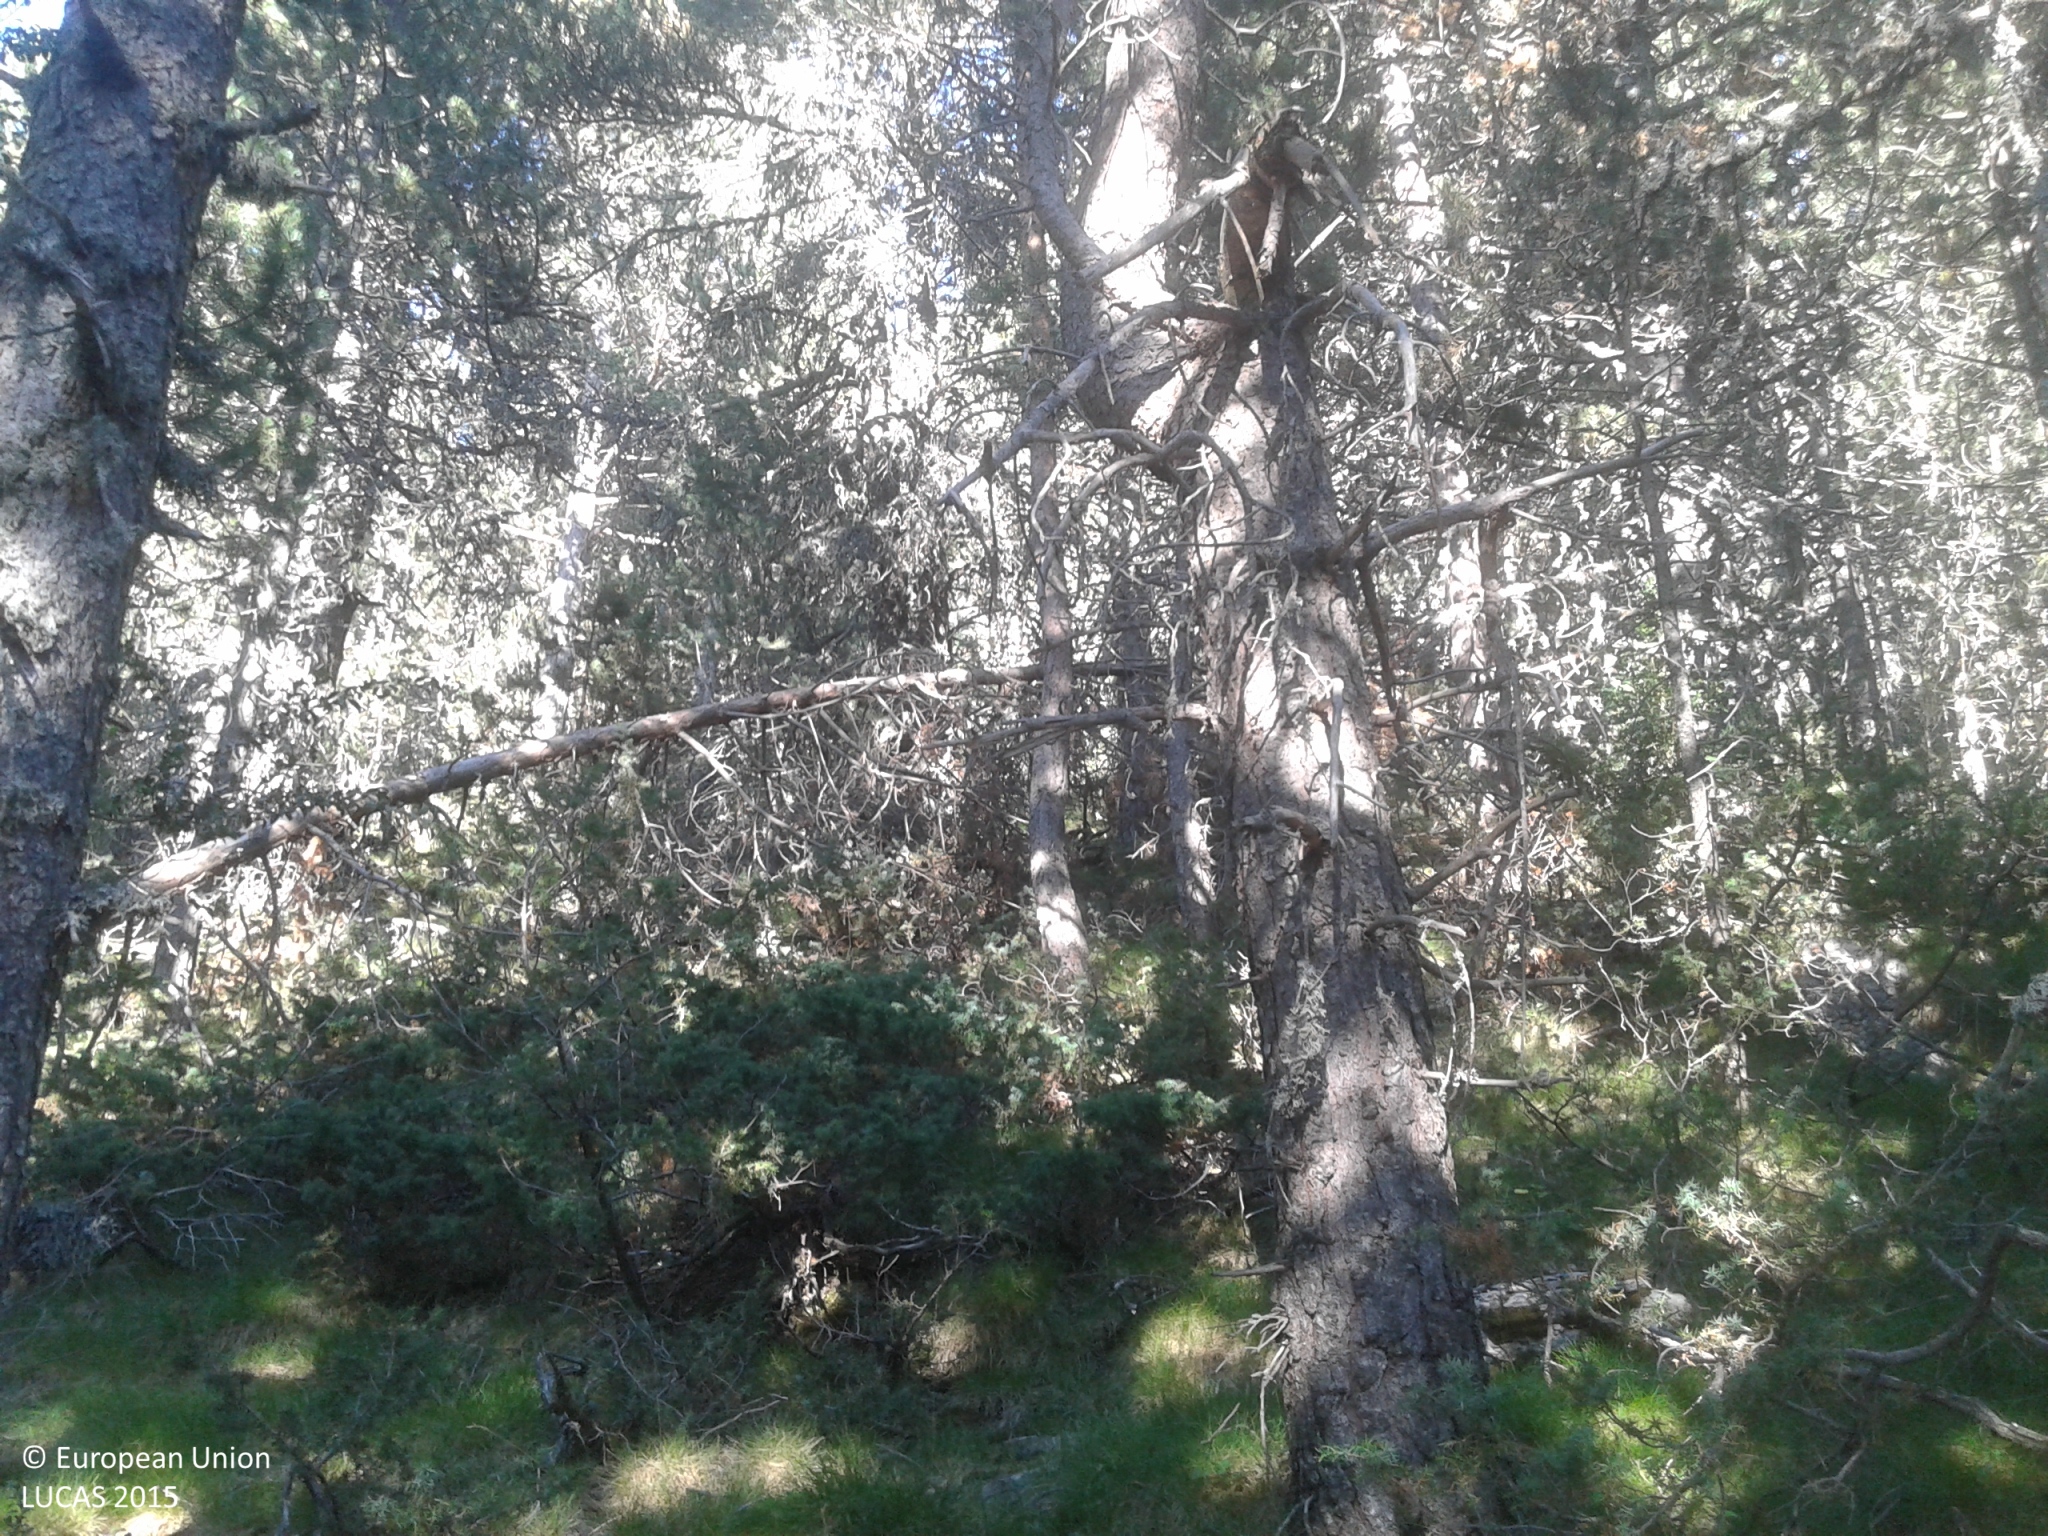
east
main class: Woodland
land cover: Pine dominated coniferous woodland
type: alpine coniferous forest
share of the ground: > 75 %
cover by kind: coniferous forest trees 80 %, herbaceous plants 15 %, shrubs 5 %
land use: Semi-natural and natural areas not in use
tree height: > 5 m
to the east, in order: Pine dominated coniferous woodland
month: July
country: ES
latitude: 42.2810
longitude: 1.5345
